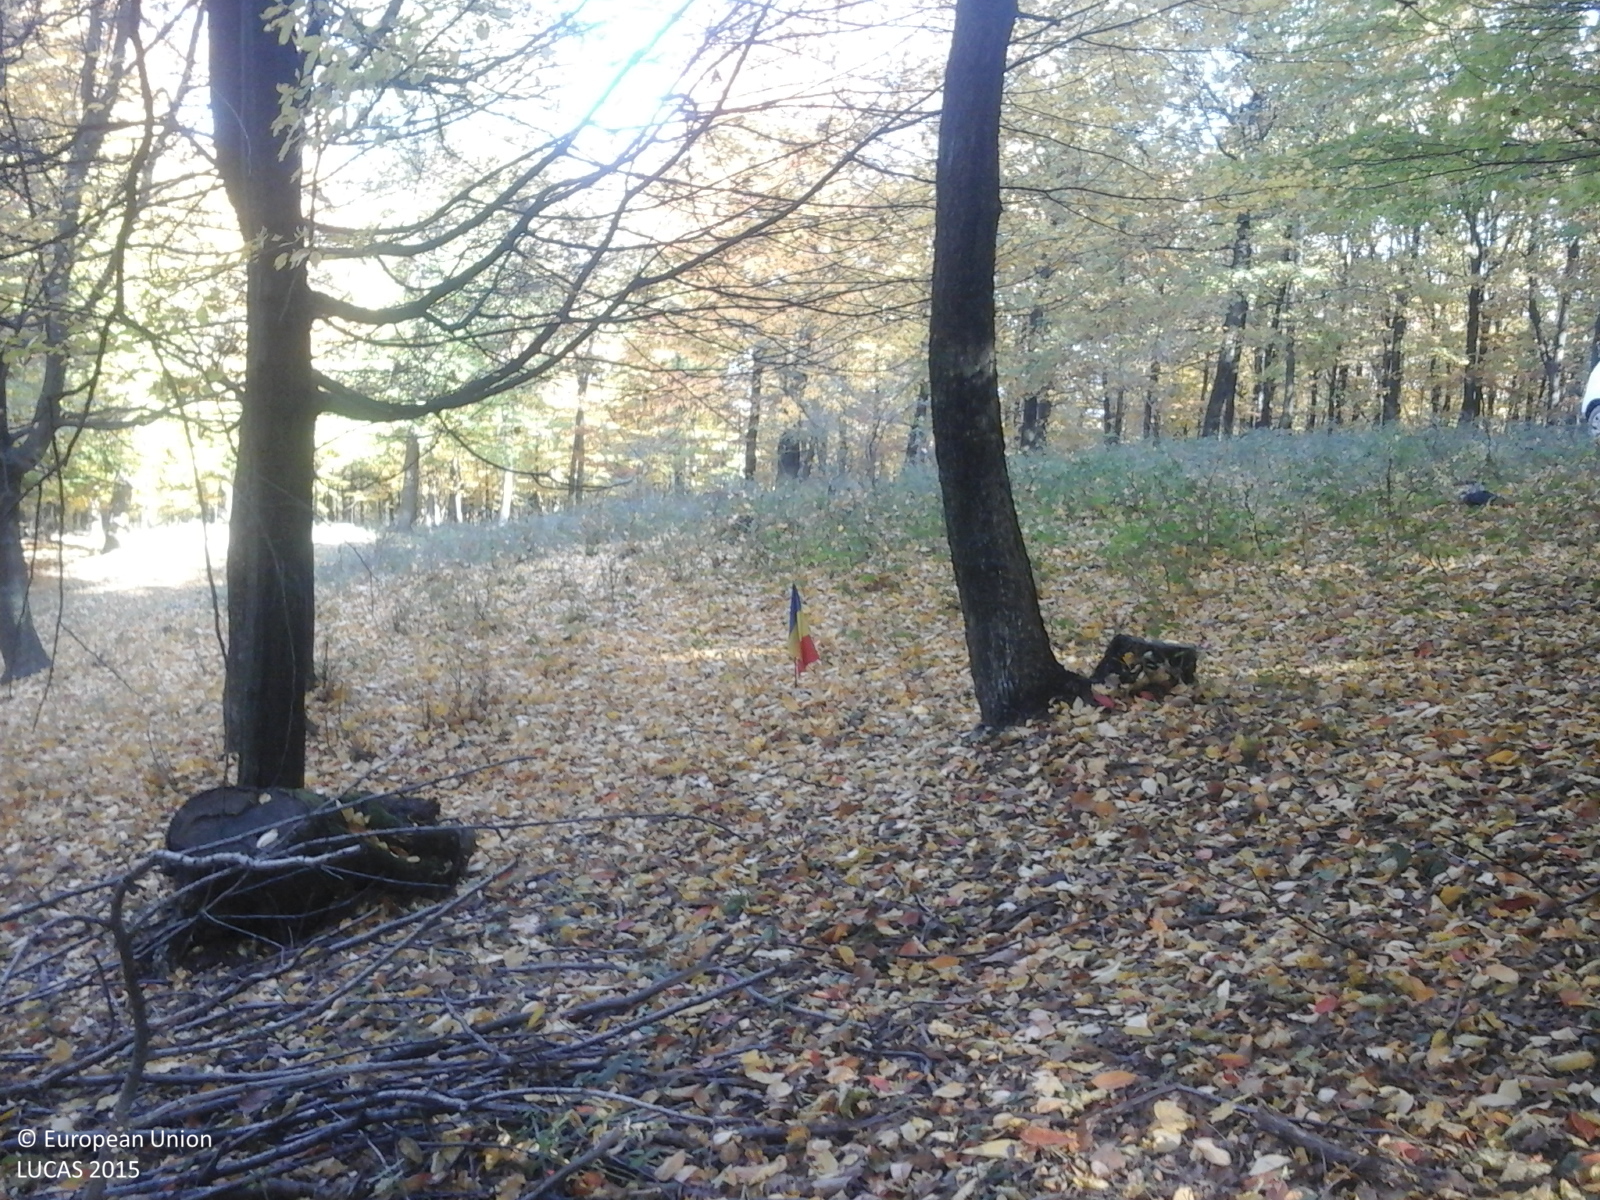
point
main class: Woodland
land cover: Broadleaved woodland
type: beech forest
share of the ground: > 75 %
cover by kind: broadleaved forest trees 100 %
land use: Forestry
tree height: > 5 m
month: October
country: RO
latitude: 46.0696
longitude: 27.0699
